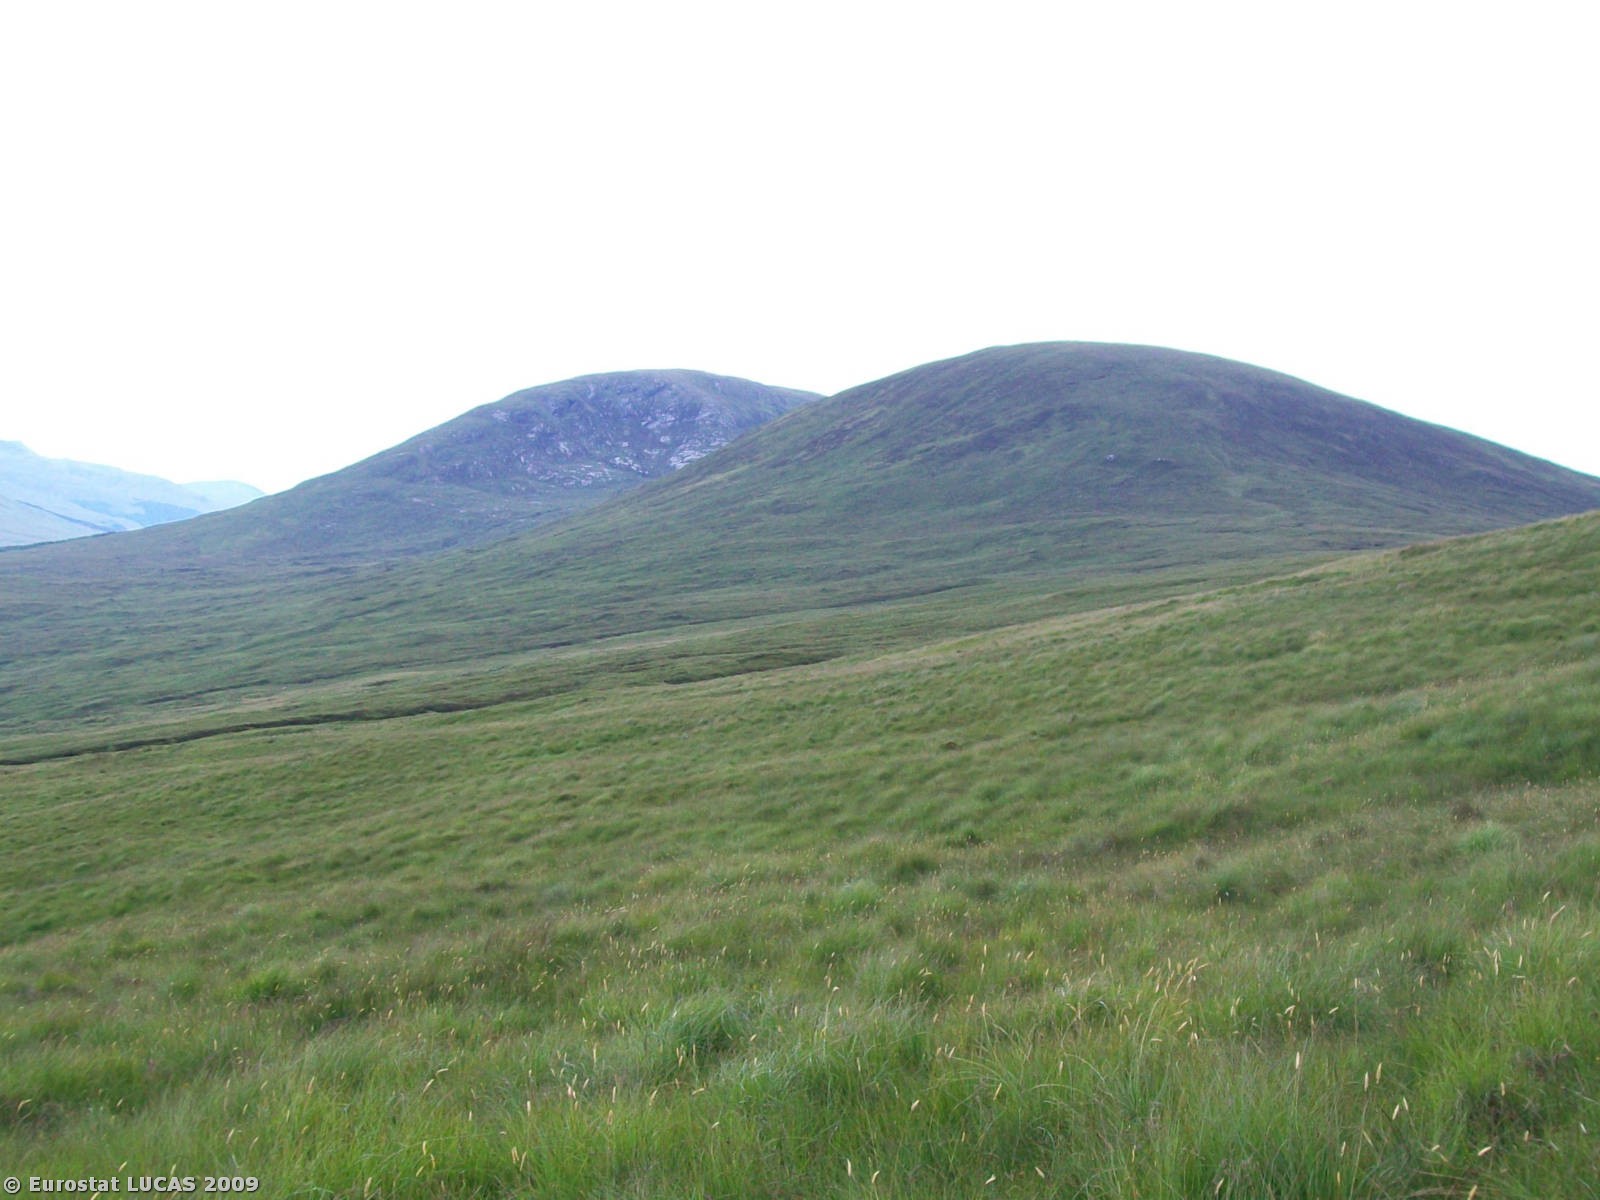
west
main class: Grassland
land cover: Grassland without tree/shrub cover
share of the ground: > 75 %
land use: Agriculture (excluding fallow land and kitchen gardens)
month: July
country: GB
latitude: 57.5573
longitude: -5.1308
